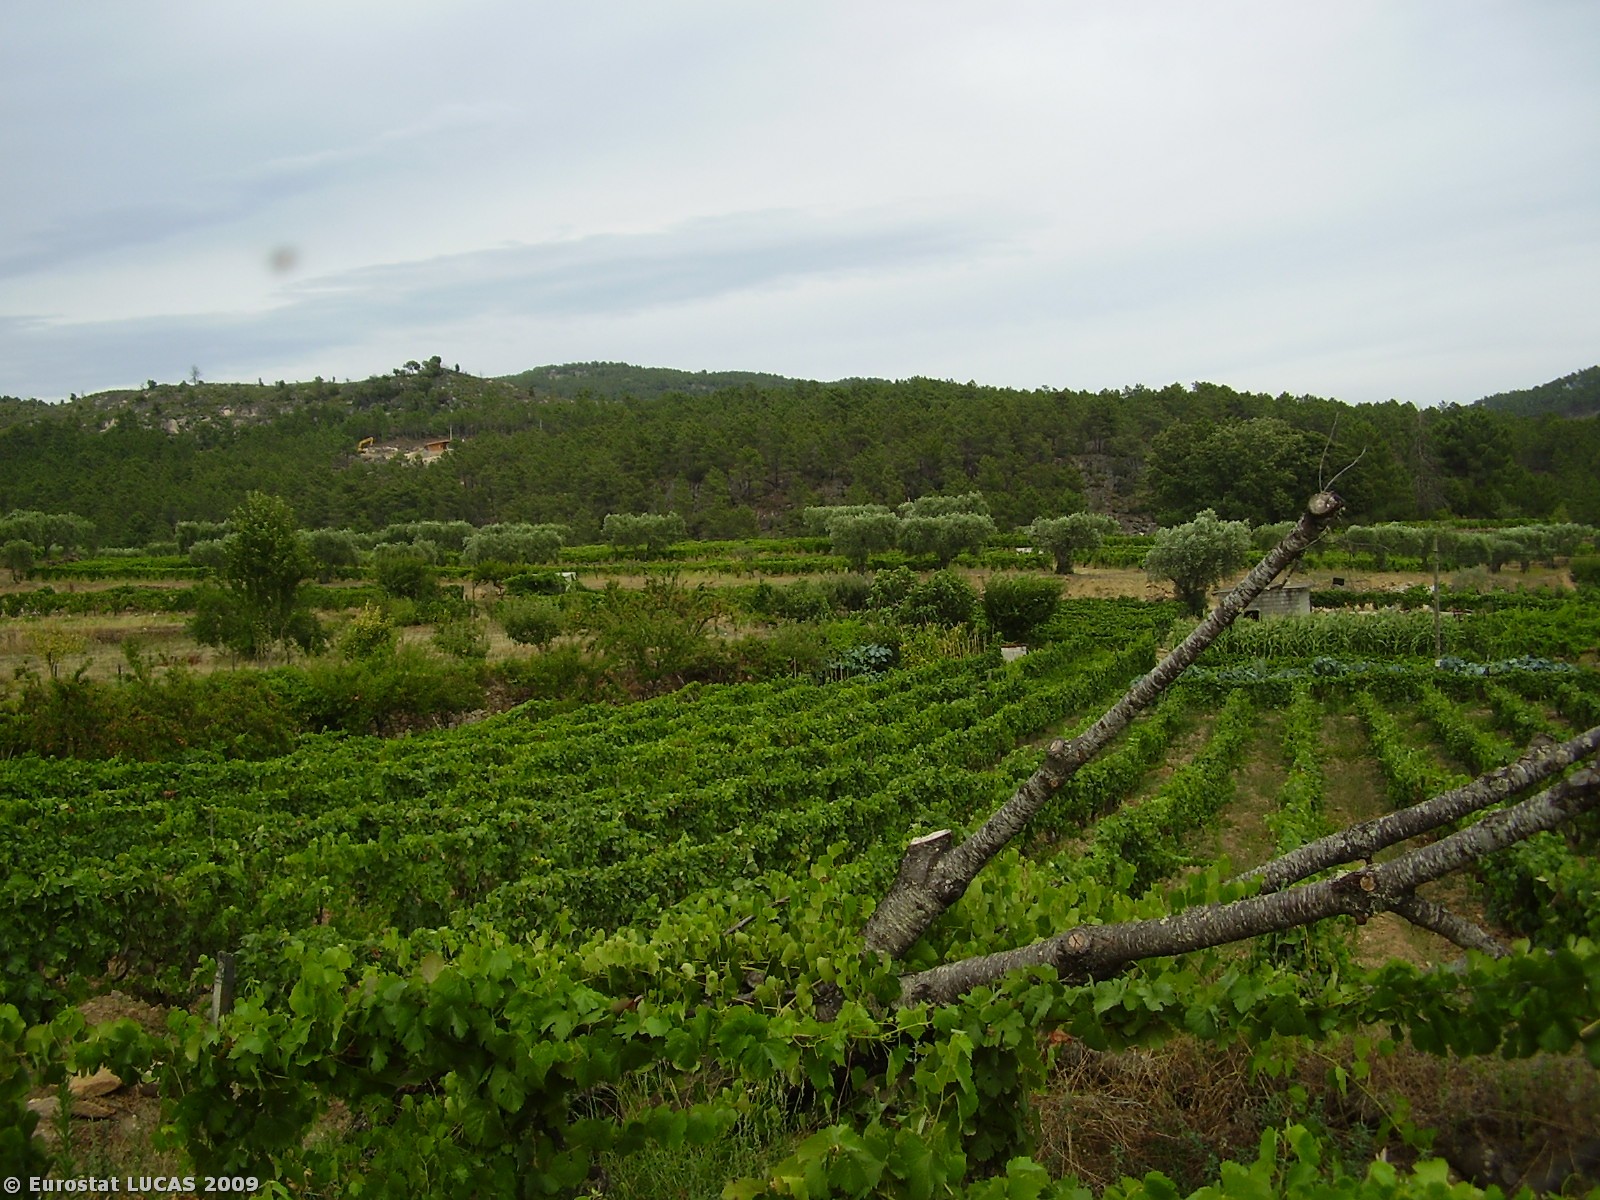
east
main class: Cropland
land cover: Vineyards
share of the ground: < 10 %
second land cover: Spontaneously vegetated surfaces
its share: < 10 %
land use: Agriculture (excluding fallow land and kitchen gardens)
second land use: Unused
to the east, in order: Vineyards; Spontaneously vegetated surfaces; Vineyards; Other fresh vegetables; Maize; Dry stone walls; Shruby margins; Vineyards; Artificial constructions in urban areas; Vineyards; Tracks; Bare land; Managed hedges; Vineyards; Broadleaved woodland; Dry stone walls; Broadleaved woodland
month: July
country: PT
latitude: 41.2563
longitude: -7.4393
